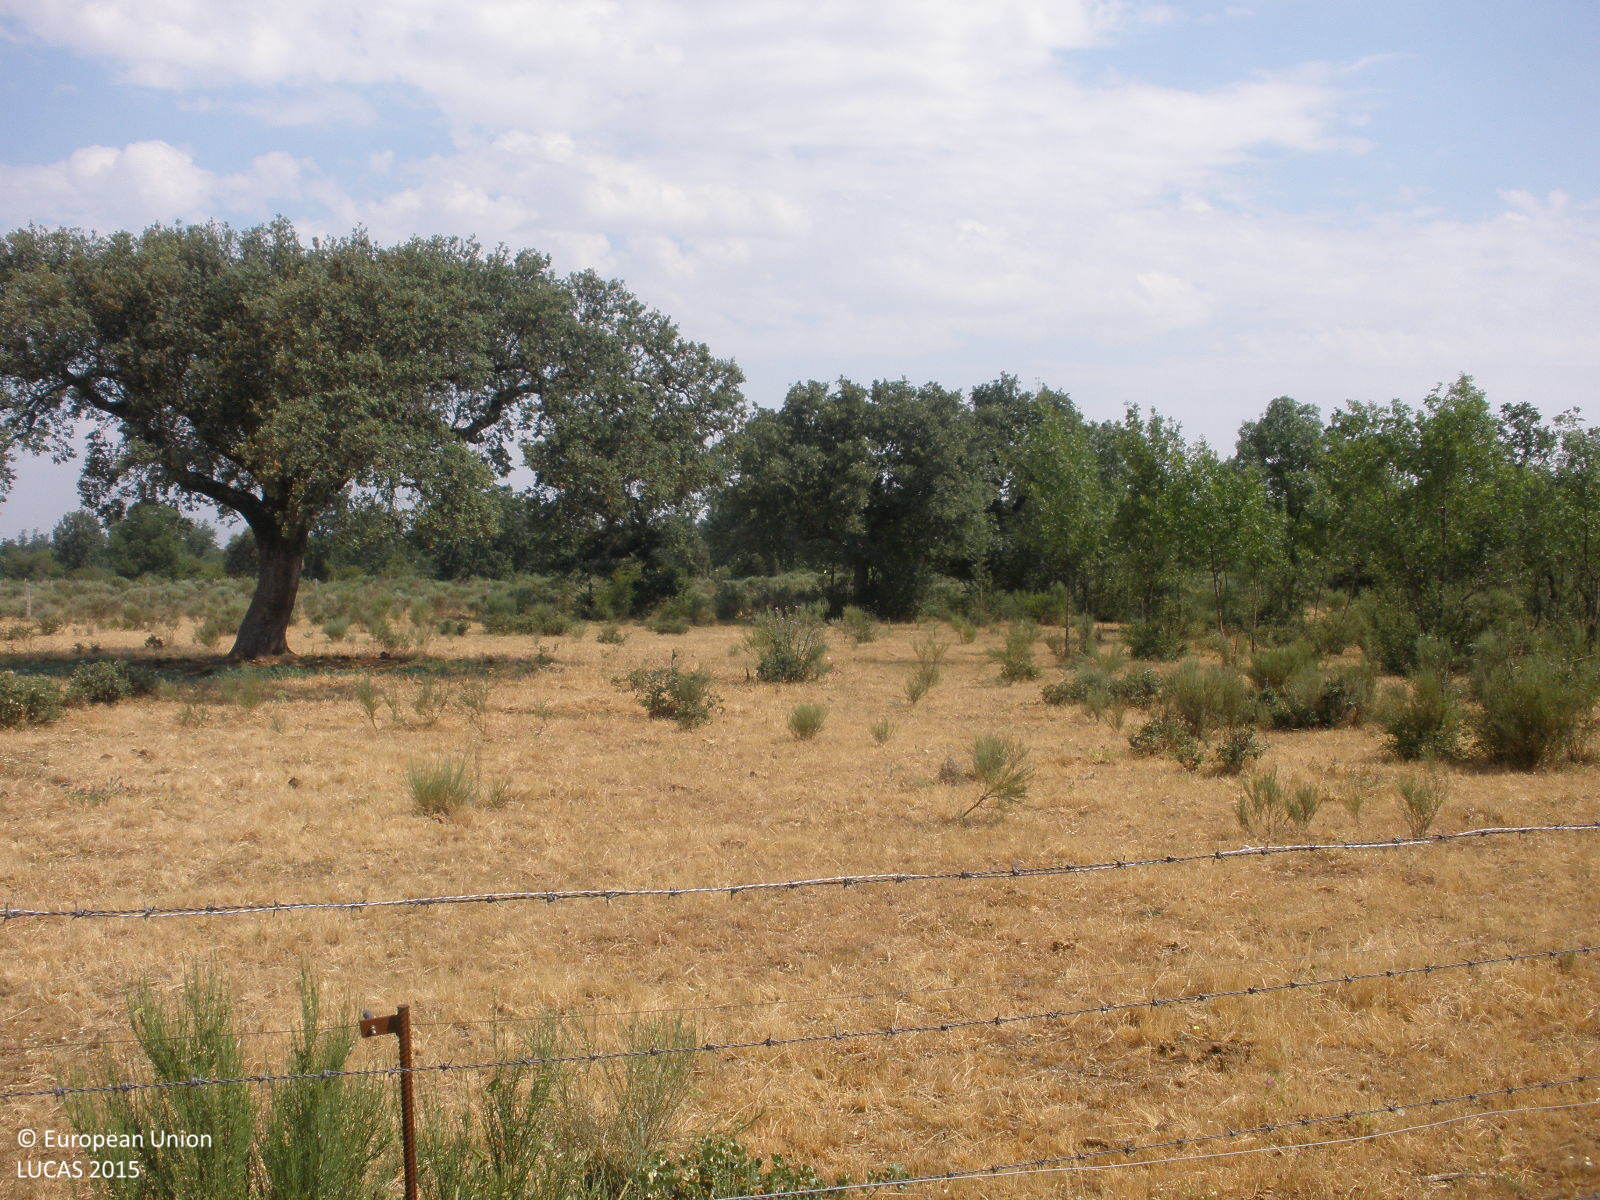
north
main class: Woodland
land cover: Broadleaved woodland
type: thermophilous deciduous forest
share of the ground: > 75 %
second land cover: Grassland without tree/shrub cover
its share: > 75 %
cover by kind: broadleaved forest trees 60 %, herbaceous plants 30 %, shrubs 10 %
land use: Forestry
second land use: Agriculture (excluding fallow land and kitchen gardens)
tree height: > 5 m
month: June
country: ES
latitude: 40.6099
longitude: -6.3853
